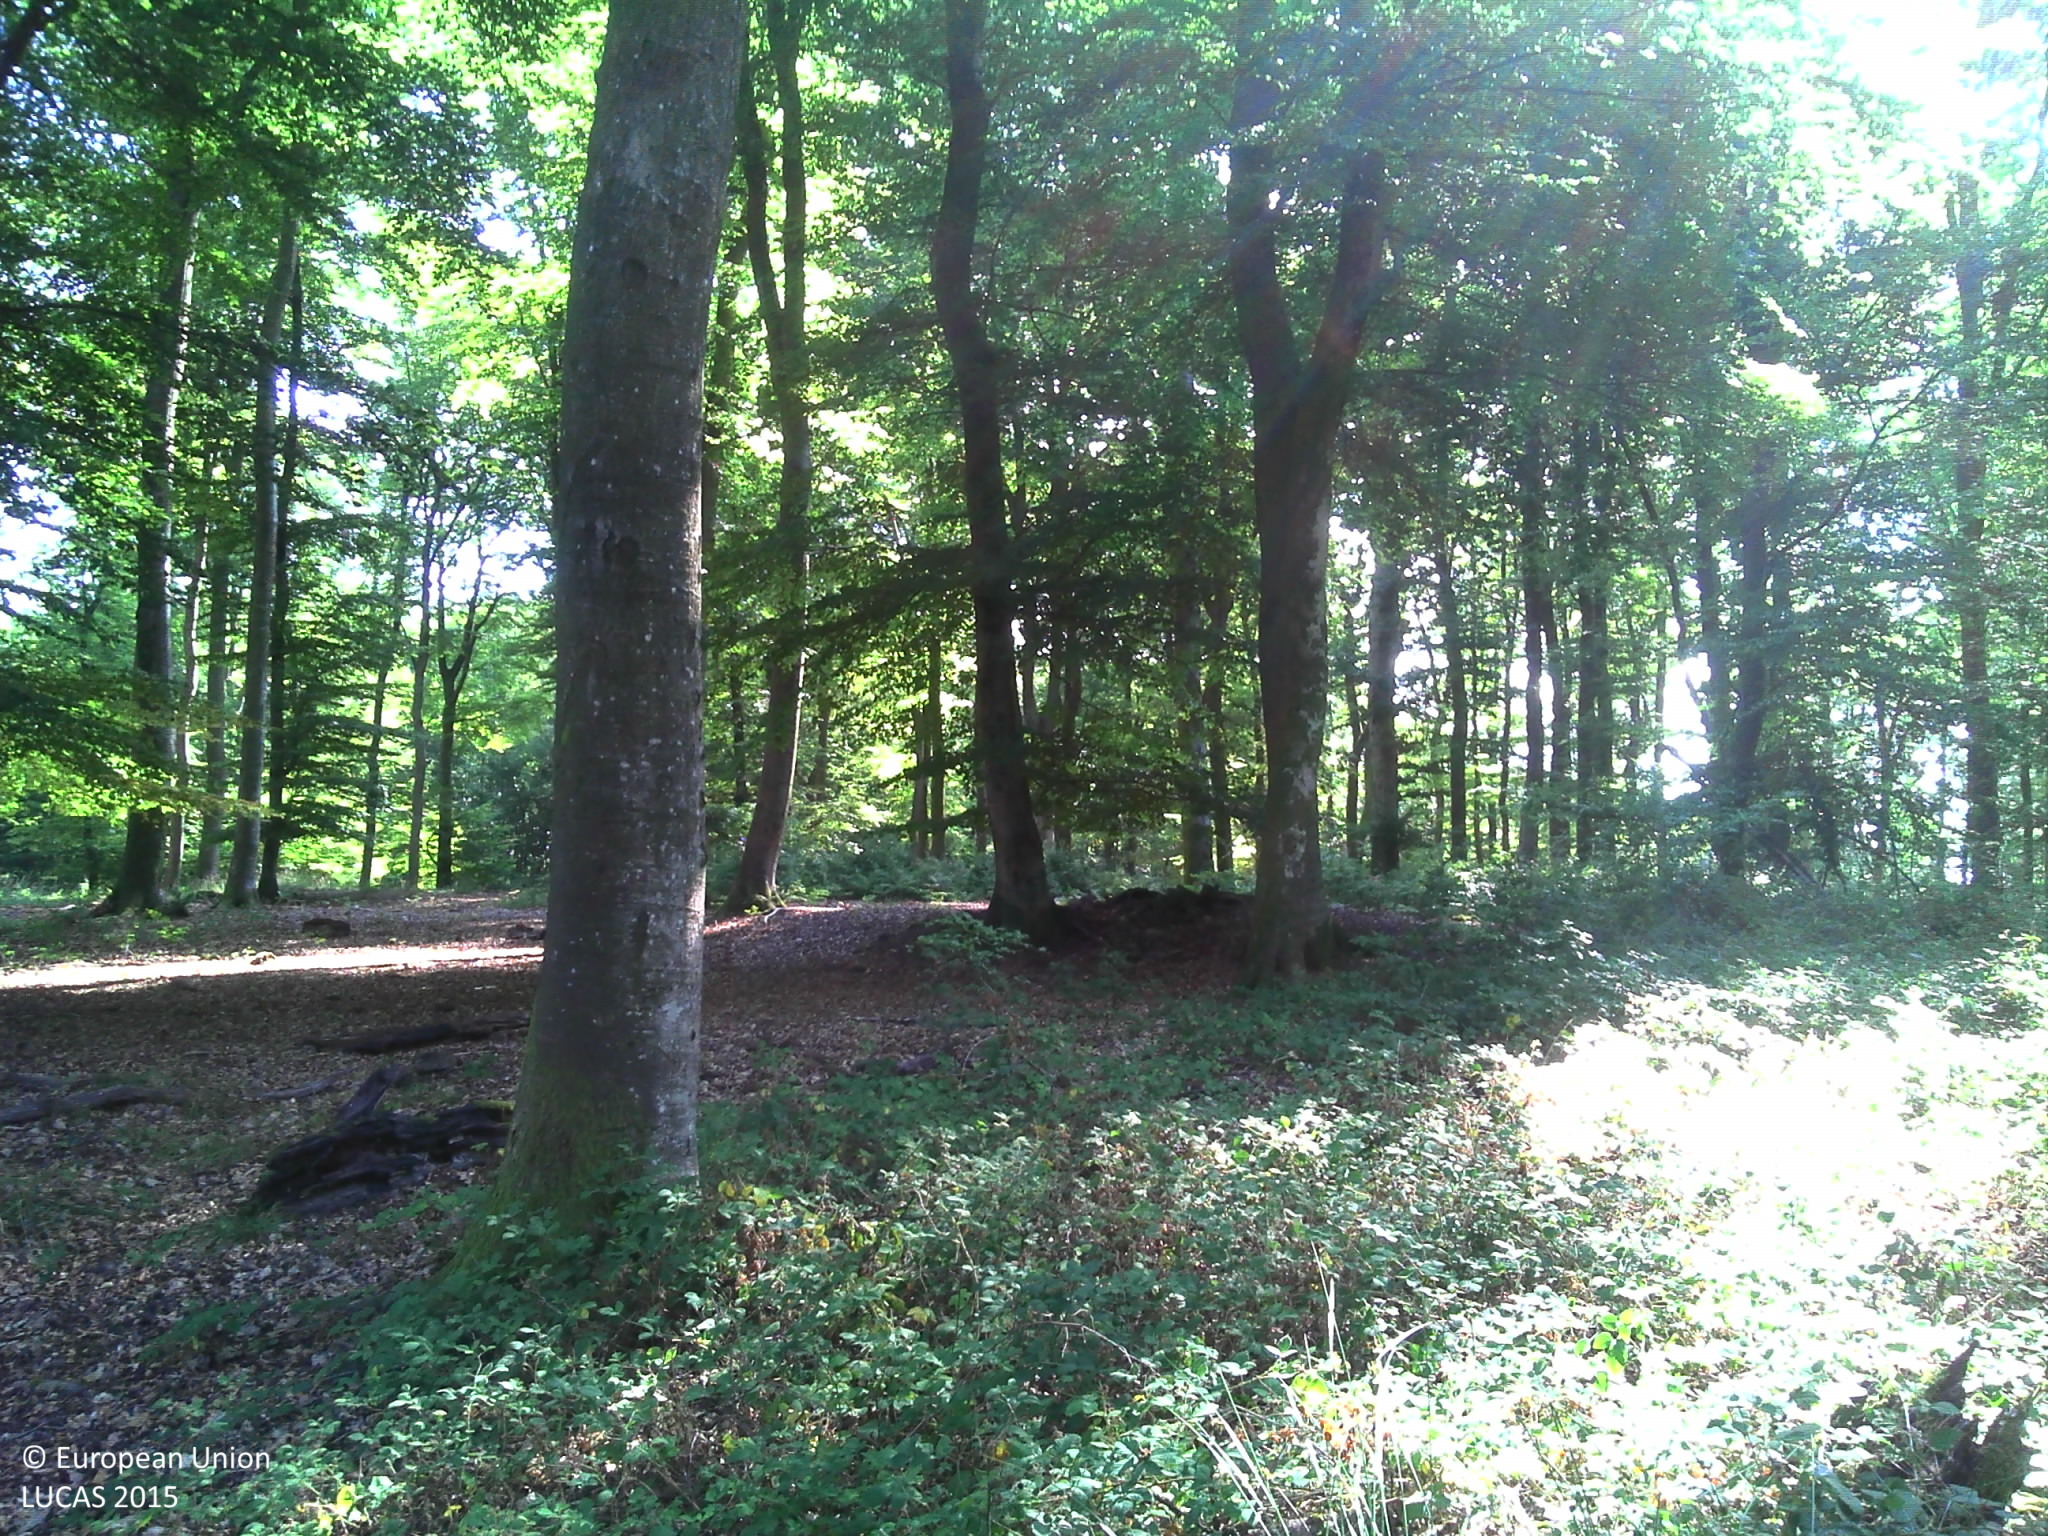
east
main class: Woodland
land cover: Broadleaved woodland
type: beech forest
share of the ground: > 75 %
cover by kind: broadleaved forest trees 95 %, herbaceous plants 5 %
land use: Forestry
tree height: > 5 m
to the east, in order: Broadleaved woodland; Tracks; Broadleaved woodland
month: August
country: FR
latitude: 48.9096
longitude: 7.2581
